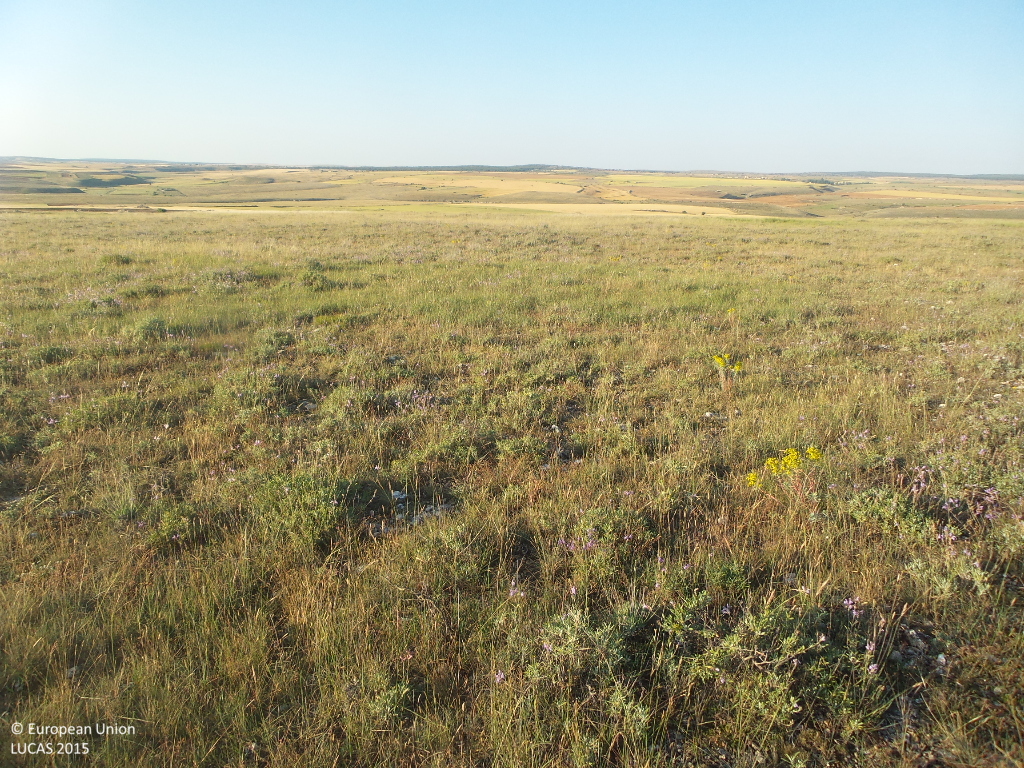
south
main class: Shrubland
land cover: Shrubland without tree cover
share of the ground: 25 - 50 %
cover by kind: shrubs 40 %, herbaceous plants 40 %, unconsolidated bare surface 20 %
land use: Semi-natural and natural areas not in use
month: June
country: ES
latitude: 41.3377
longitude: -2.7149
